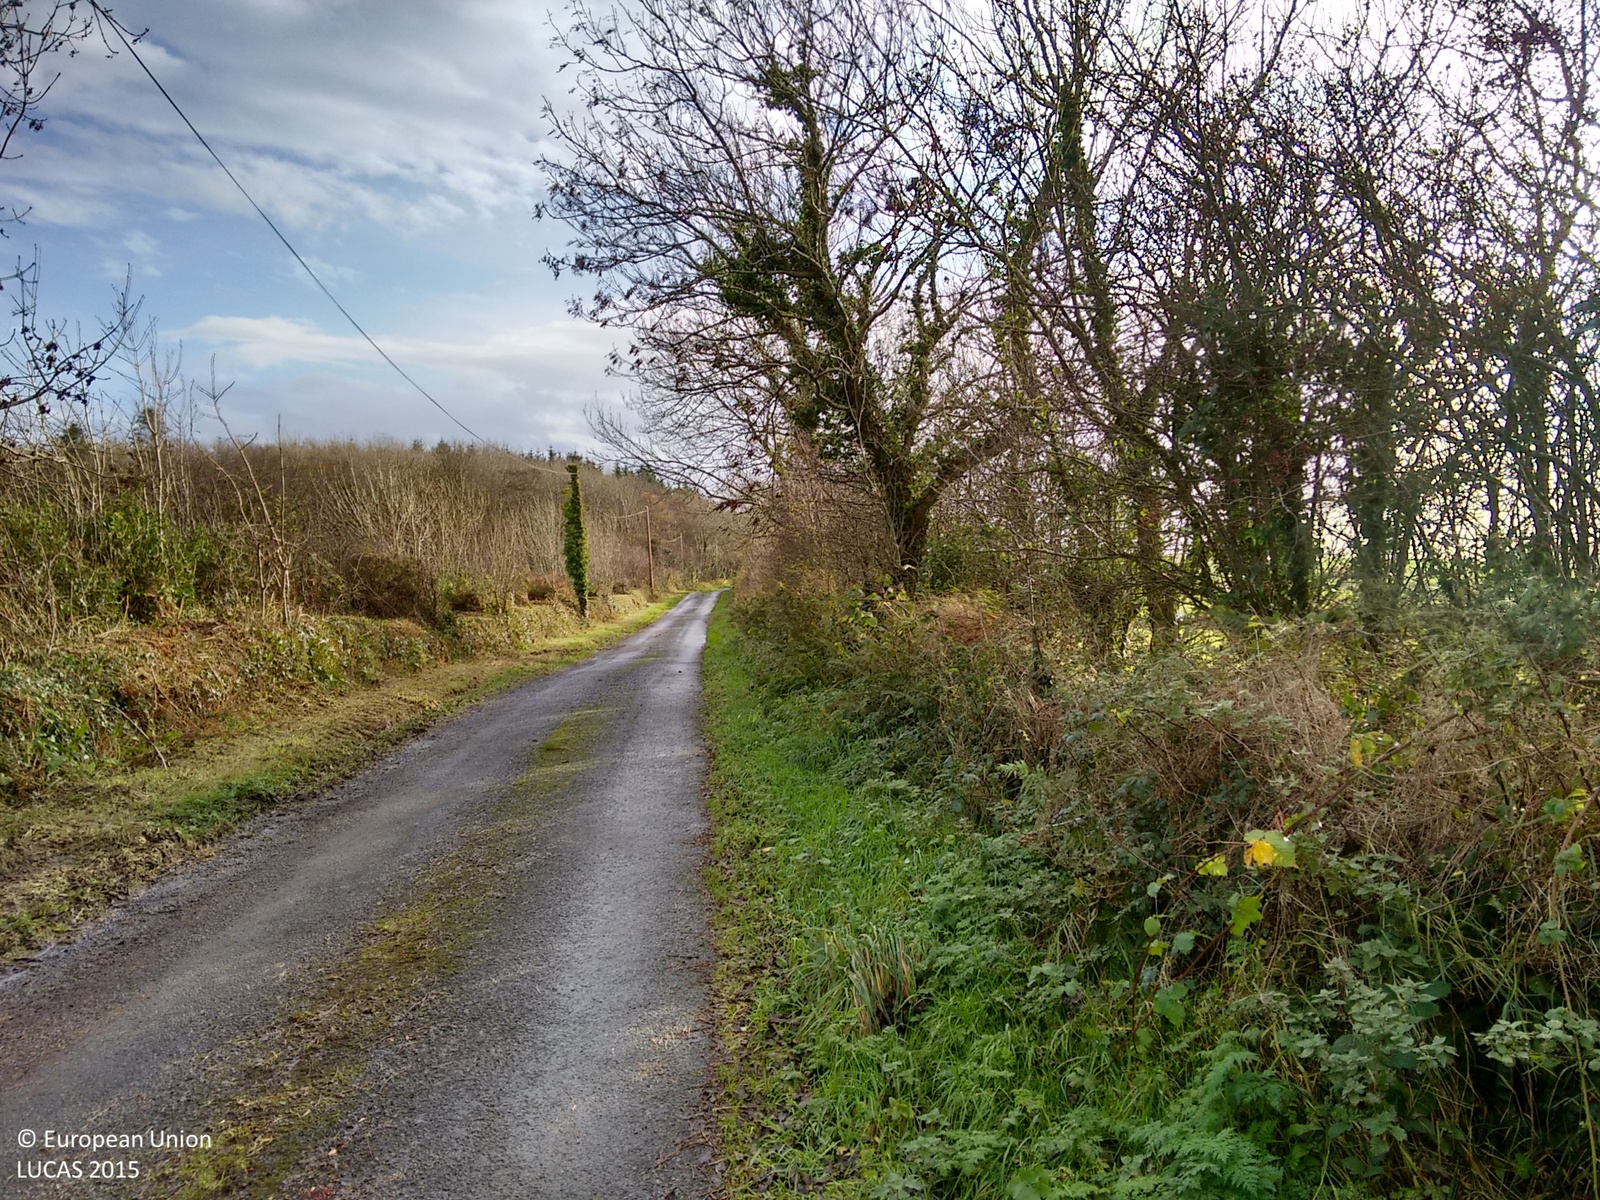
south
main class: Grassland
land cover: Grassland without tree/shrub cover
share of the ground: > 75 %
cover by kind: herbaceous plants 100 %
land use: Agriculture (excluding fallow land and kitchen gardens)
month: November
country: IE
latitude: 54.3535
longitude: -8.5493
